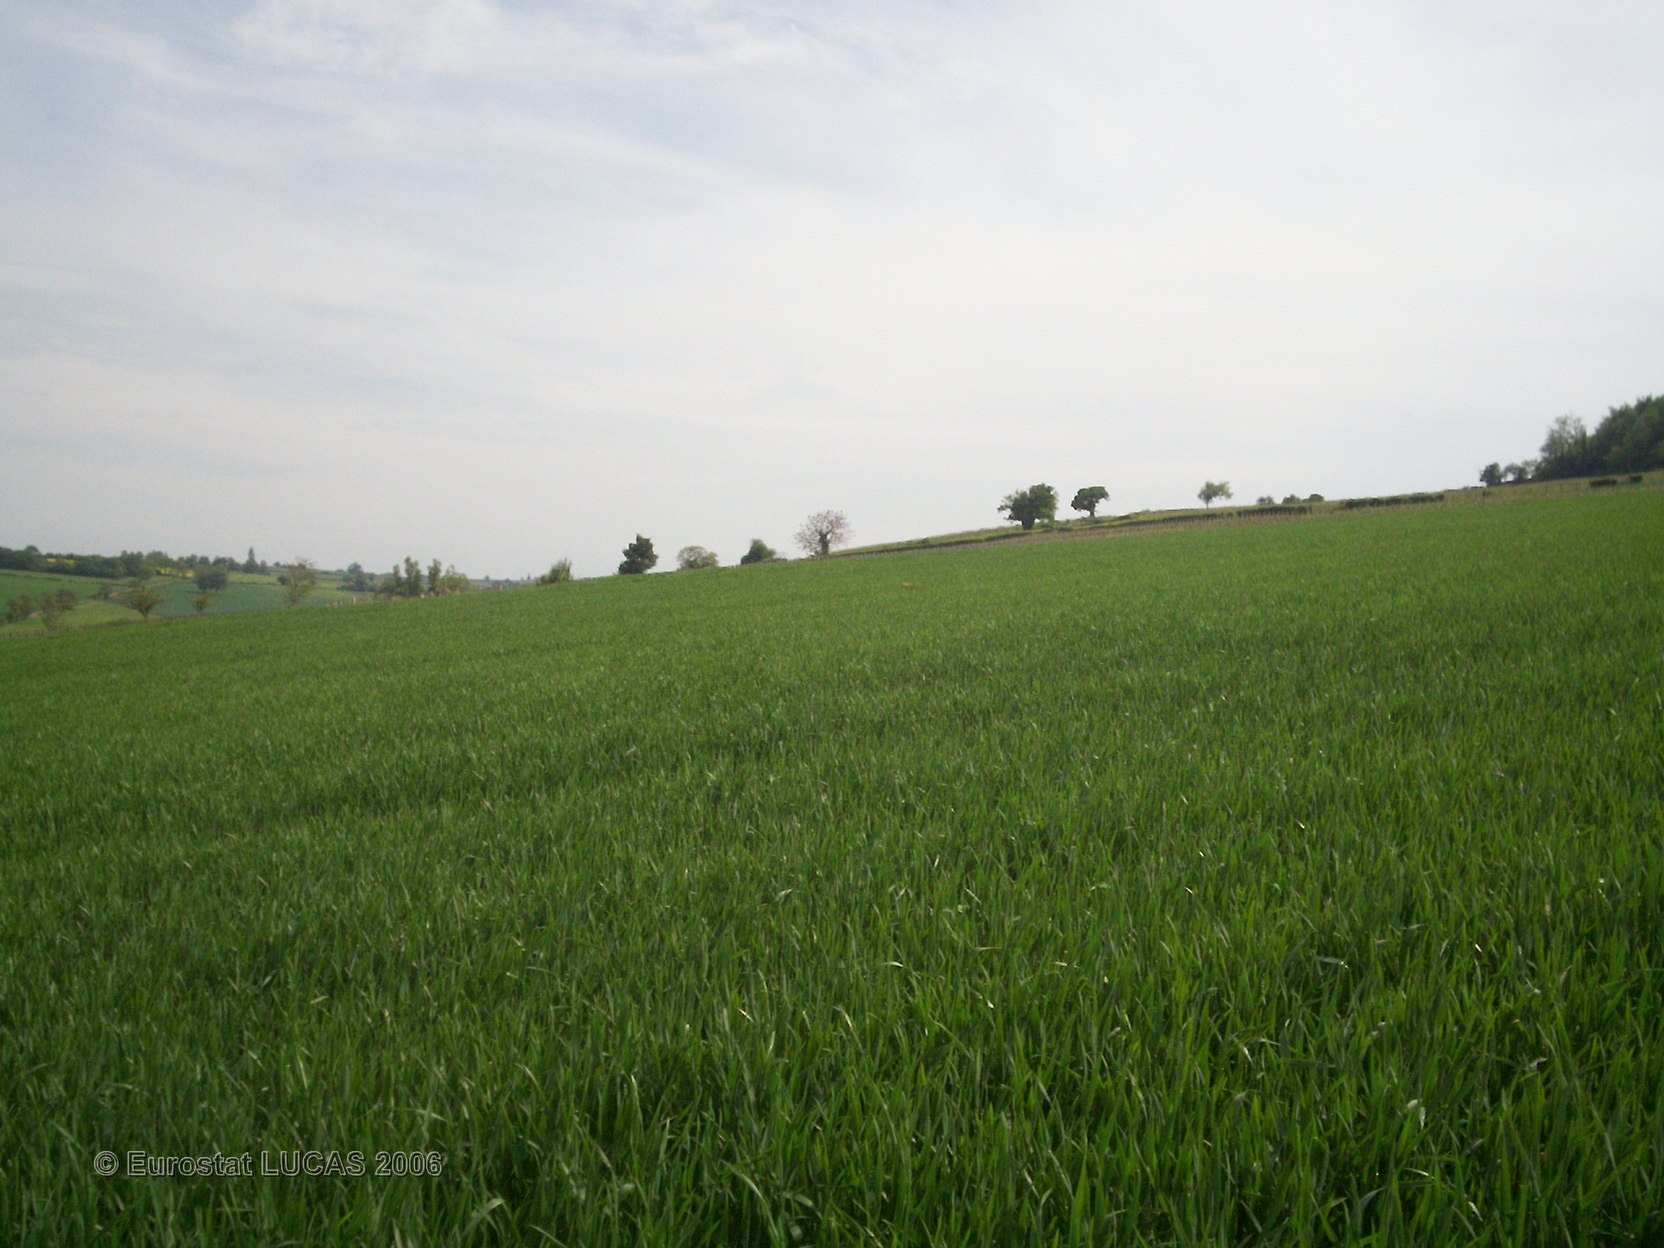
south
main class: Cropland
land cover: Common wheat
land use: Agriculture (excluding fallow land and kitchen gardens)
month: May
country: FR
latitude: 46.6675
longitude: 4.6292
